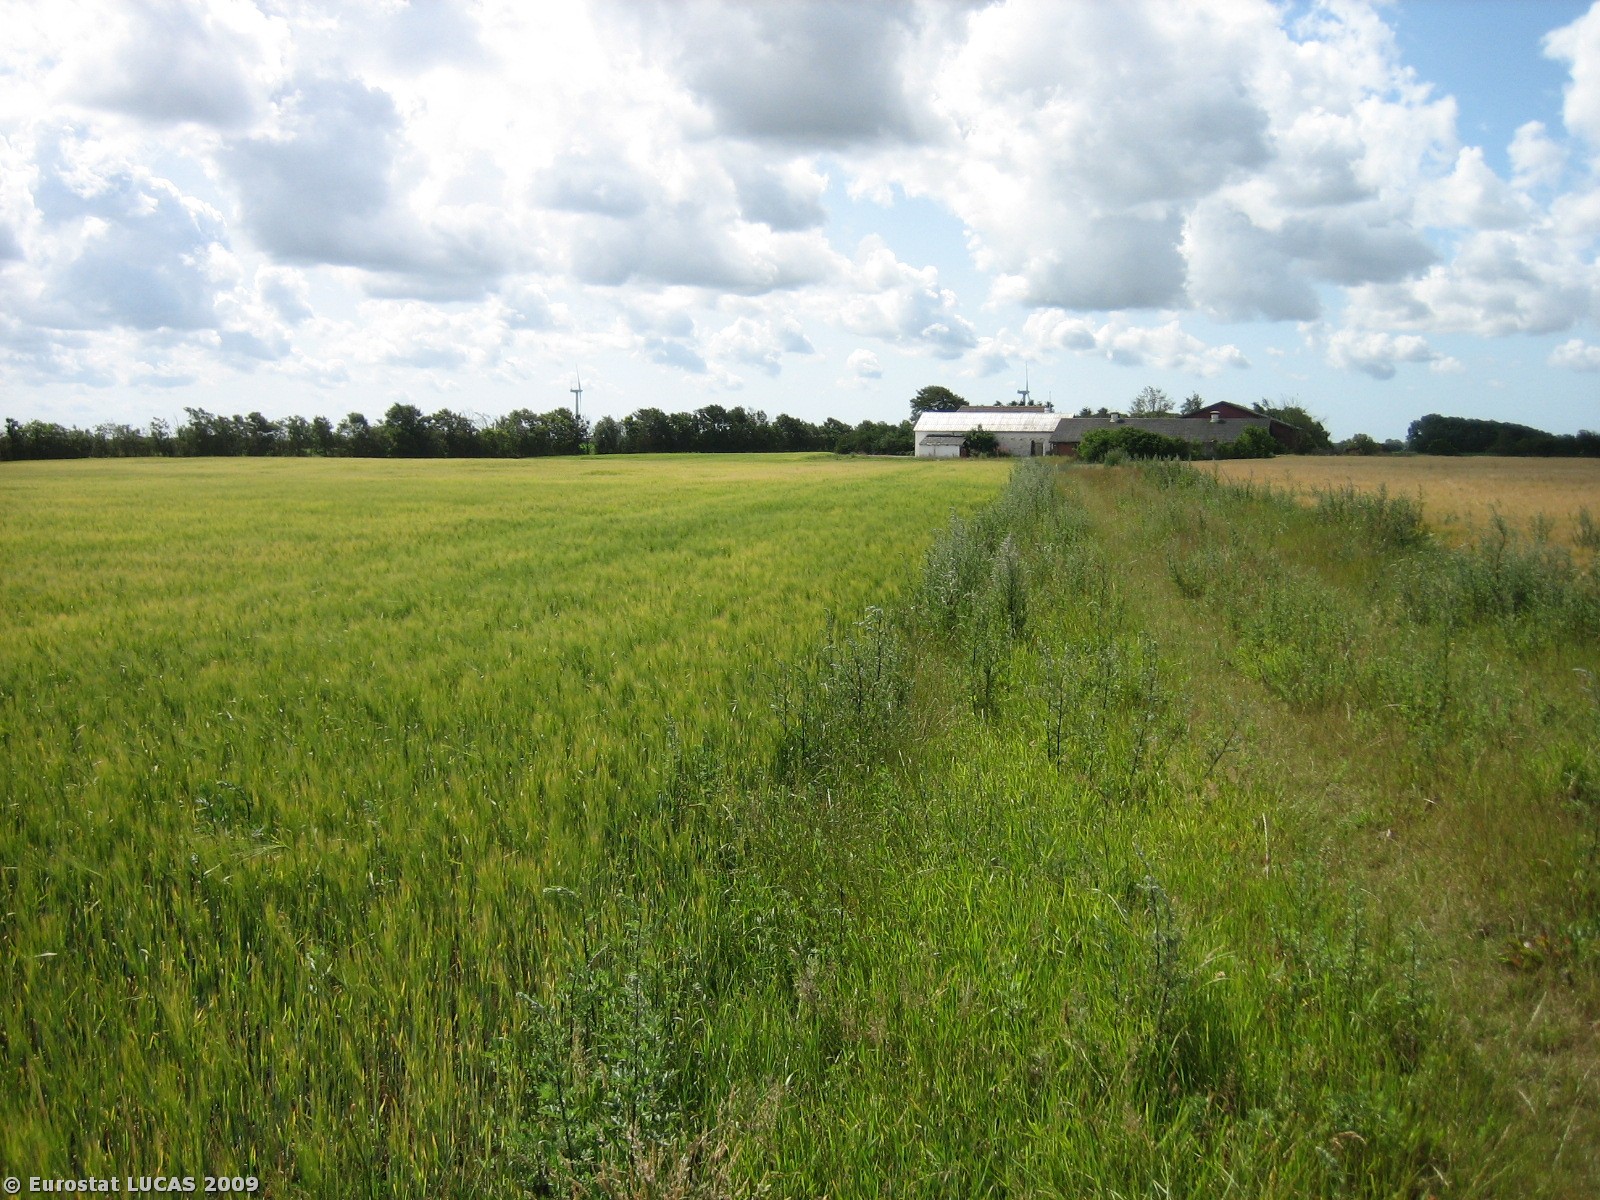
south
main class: Cropland
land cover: Barley
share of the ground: > 75 %
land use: Agriculture (excluding fallow land and kitchen gardens)
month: July
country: DK
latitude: 55.7481
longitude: 8.5517
